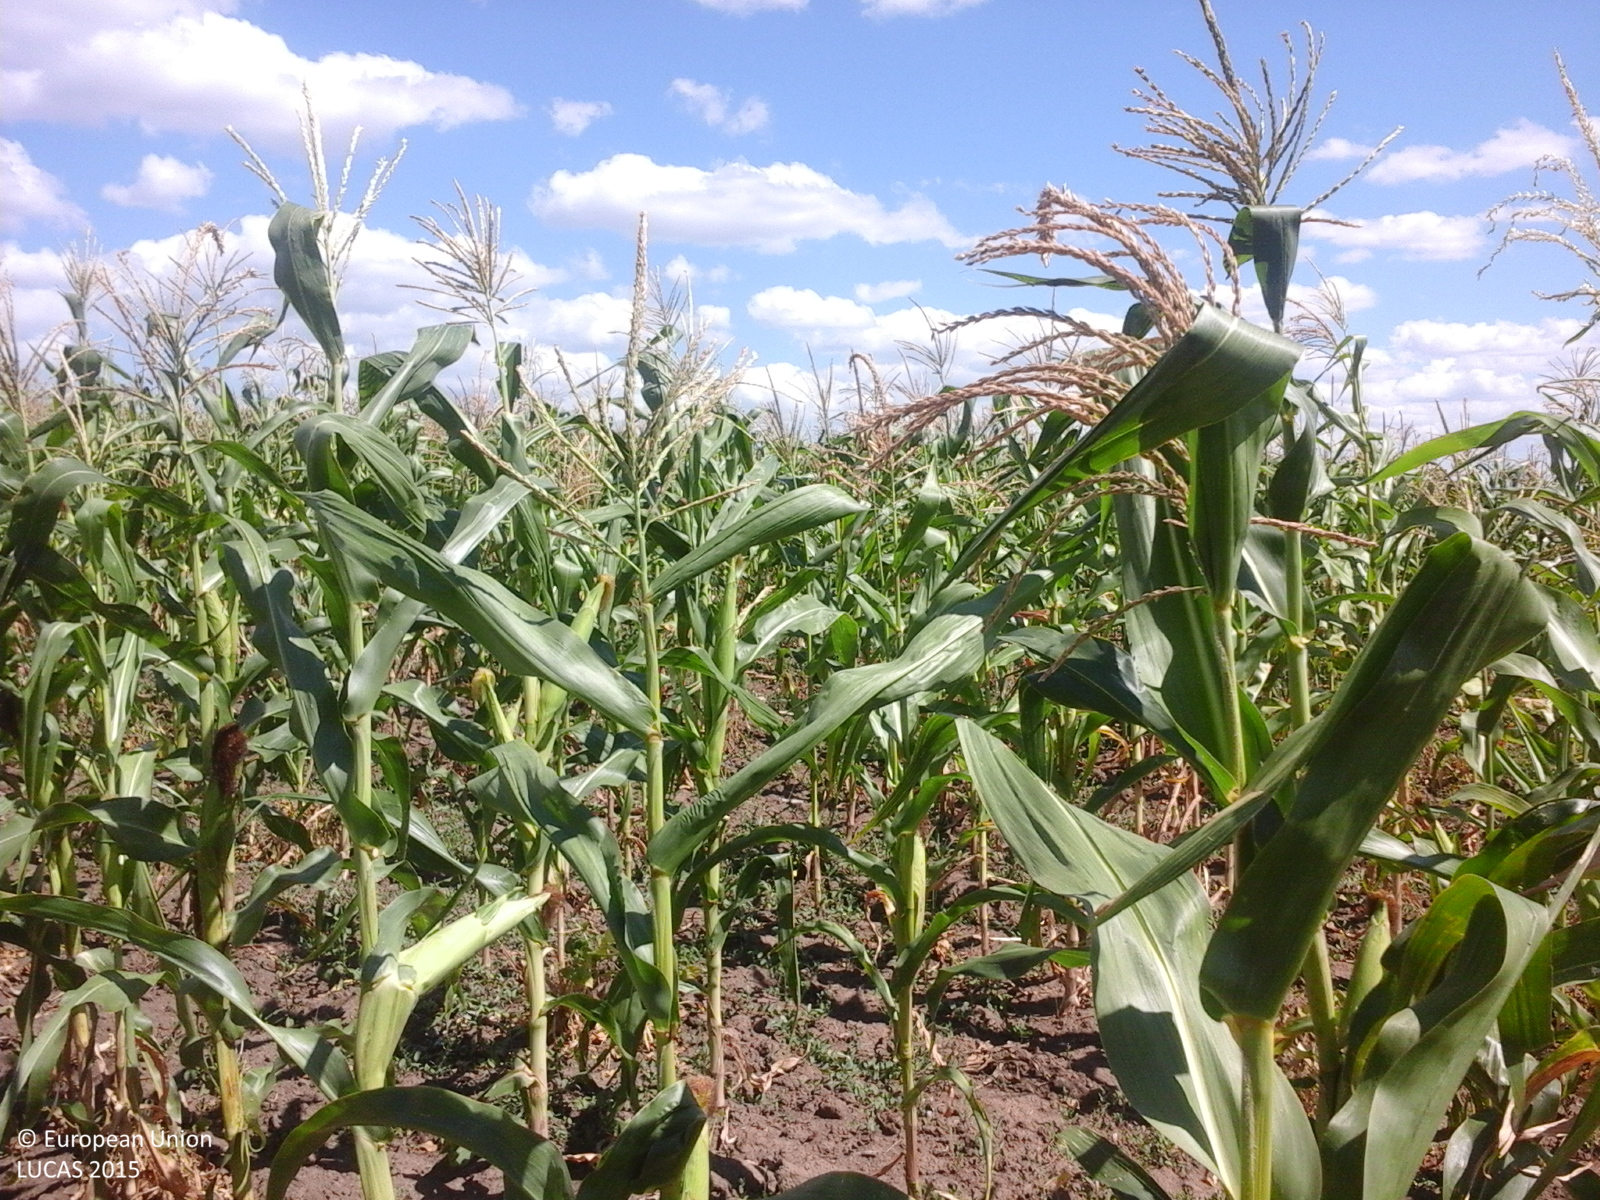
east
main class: Cropland
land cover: Maize
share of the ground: > 75 %
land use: Agriculture (excluding fallow land and kitchen gardens)
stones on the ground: < 10 %
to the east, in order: Maize; Tracks; Grassland without tree/shrub cover; Tracks; Maize; Sunflower; Maize; Sunflower
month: July
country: RO
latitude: 45.9913
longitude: 27.7632
